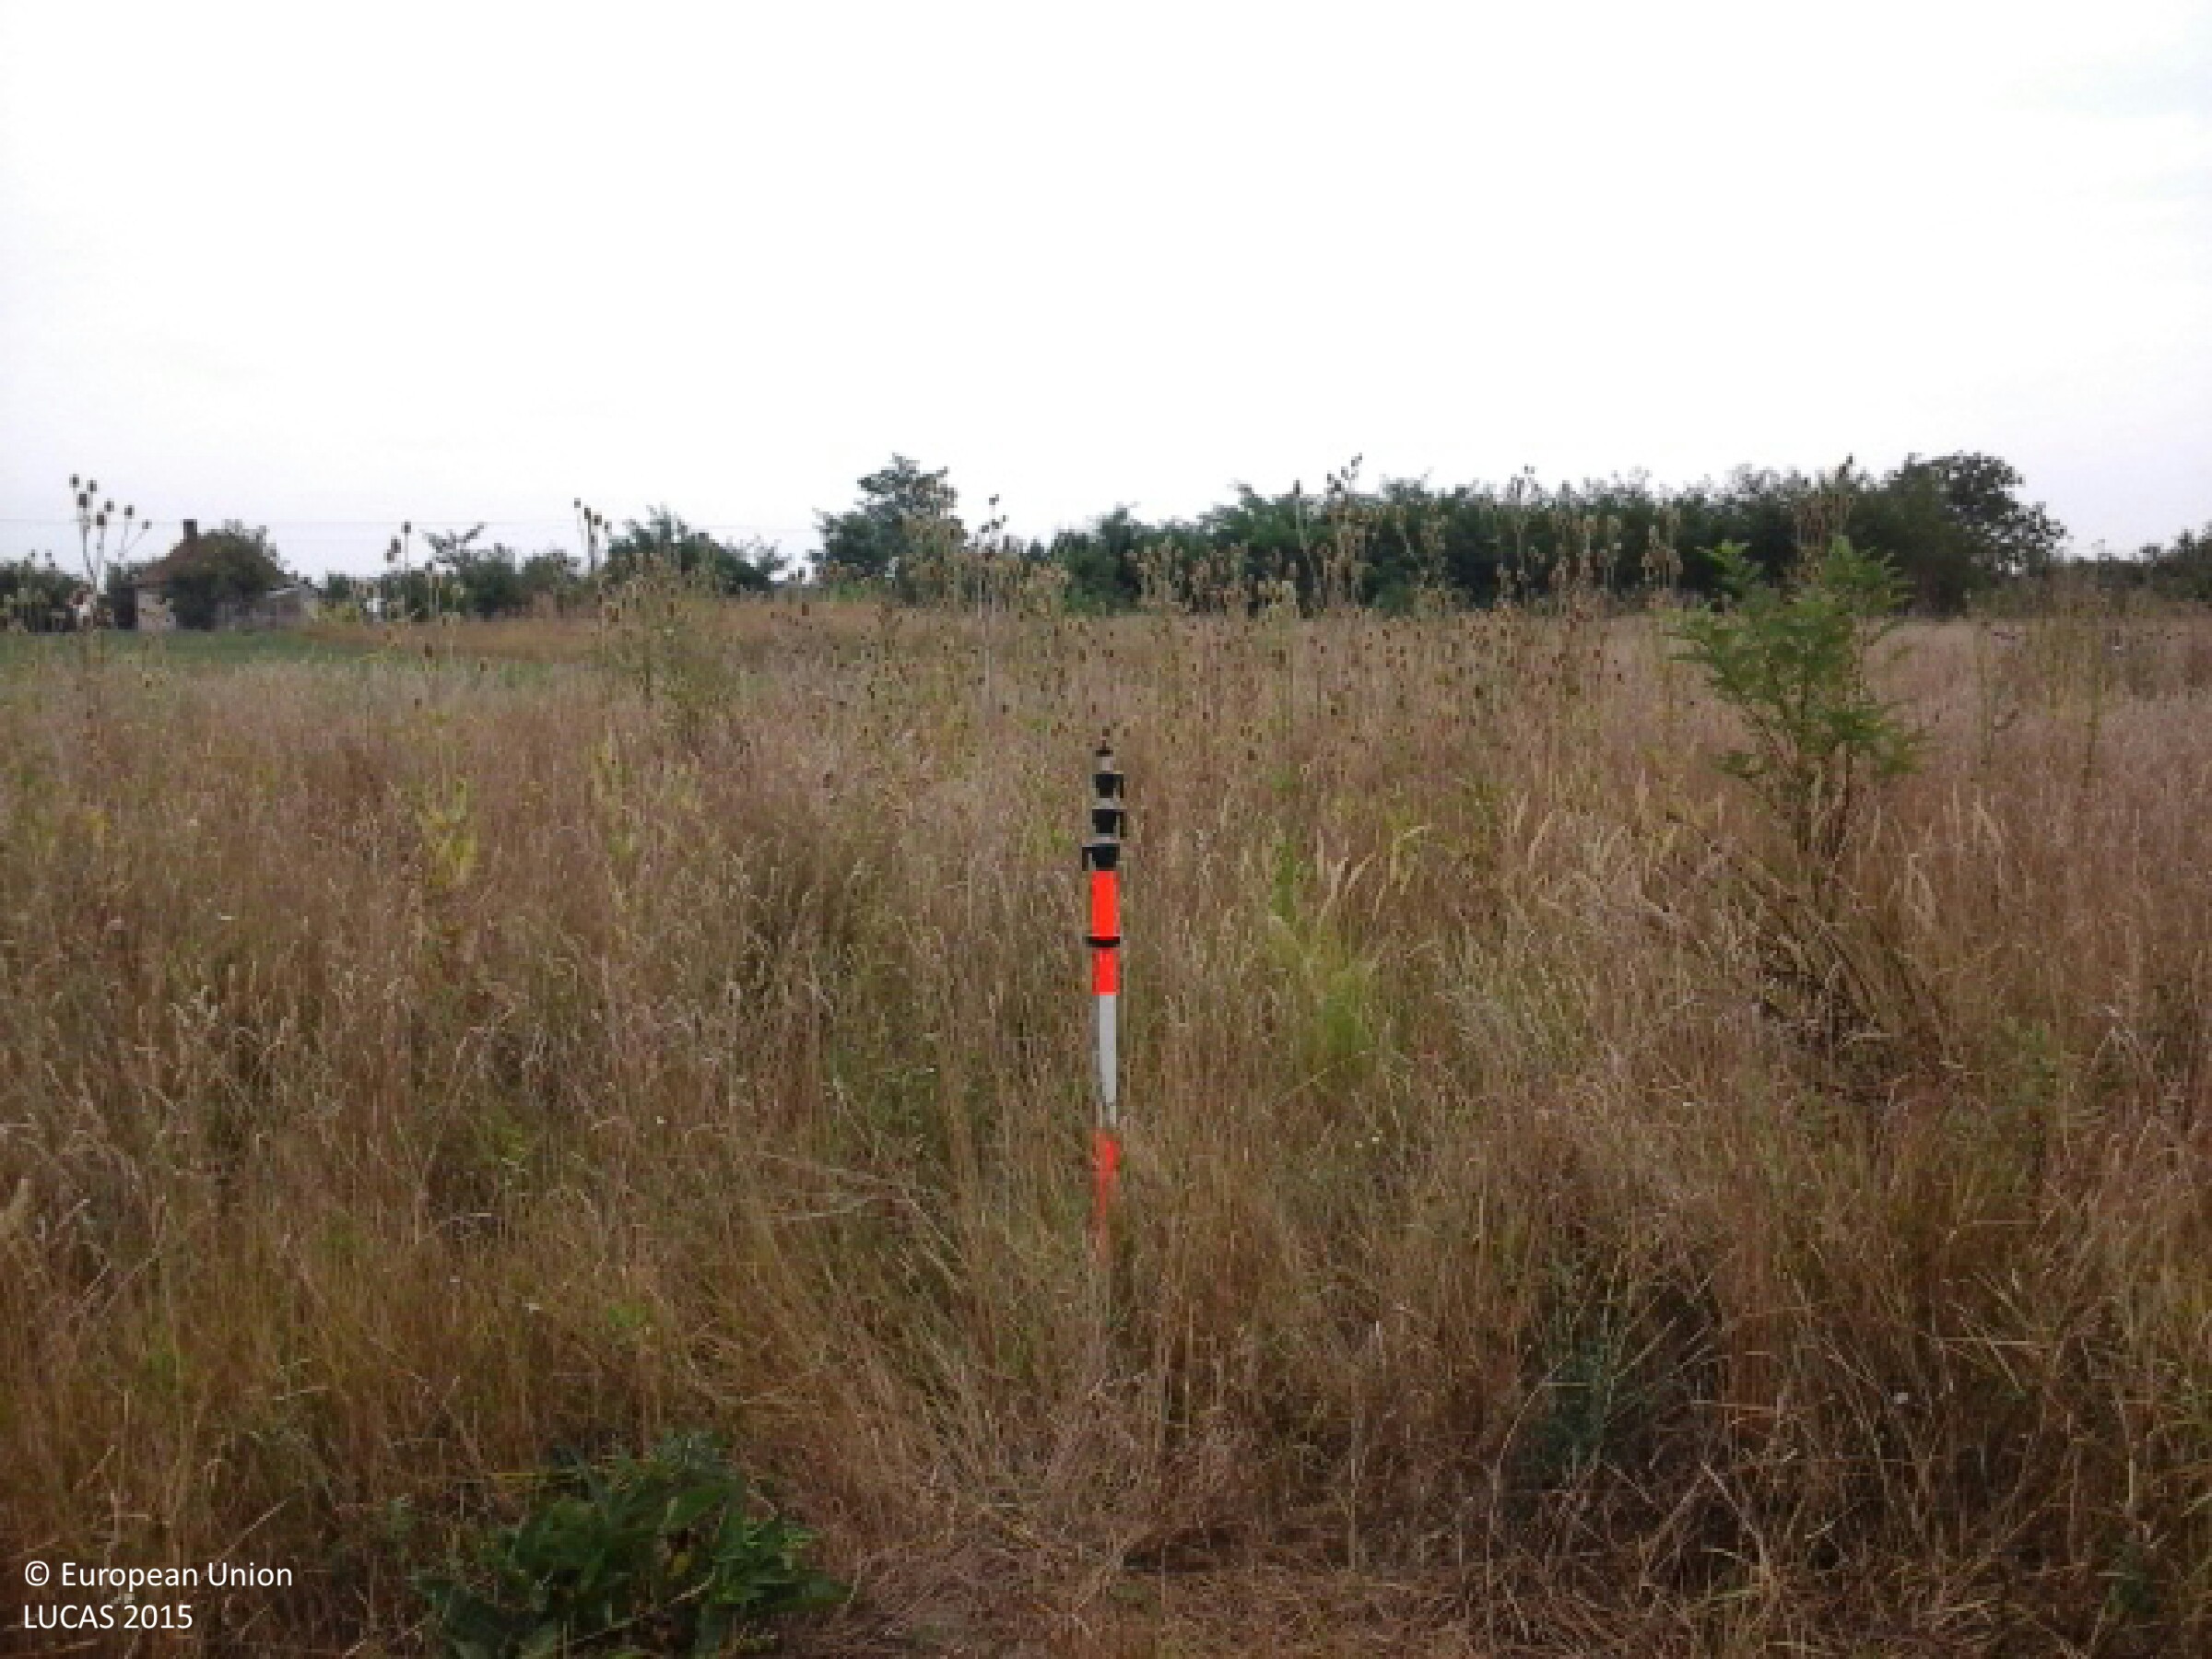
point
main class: Grassland
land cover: Spontaneously vegetated surfaces
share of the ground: > 75 %
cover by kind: herbaceous plants 100 %
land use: Semi-natural and natural areas not in use
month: August
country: HU
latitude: 47.1513
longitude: 21.7958
